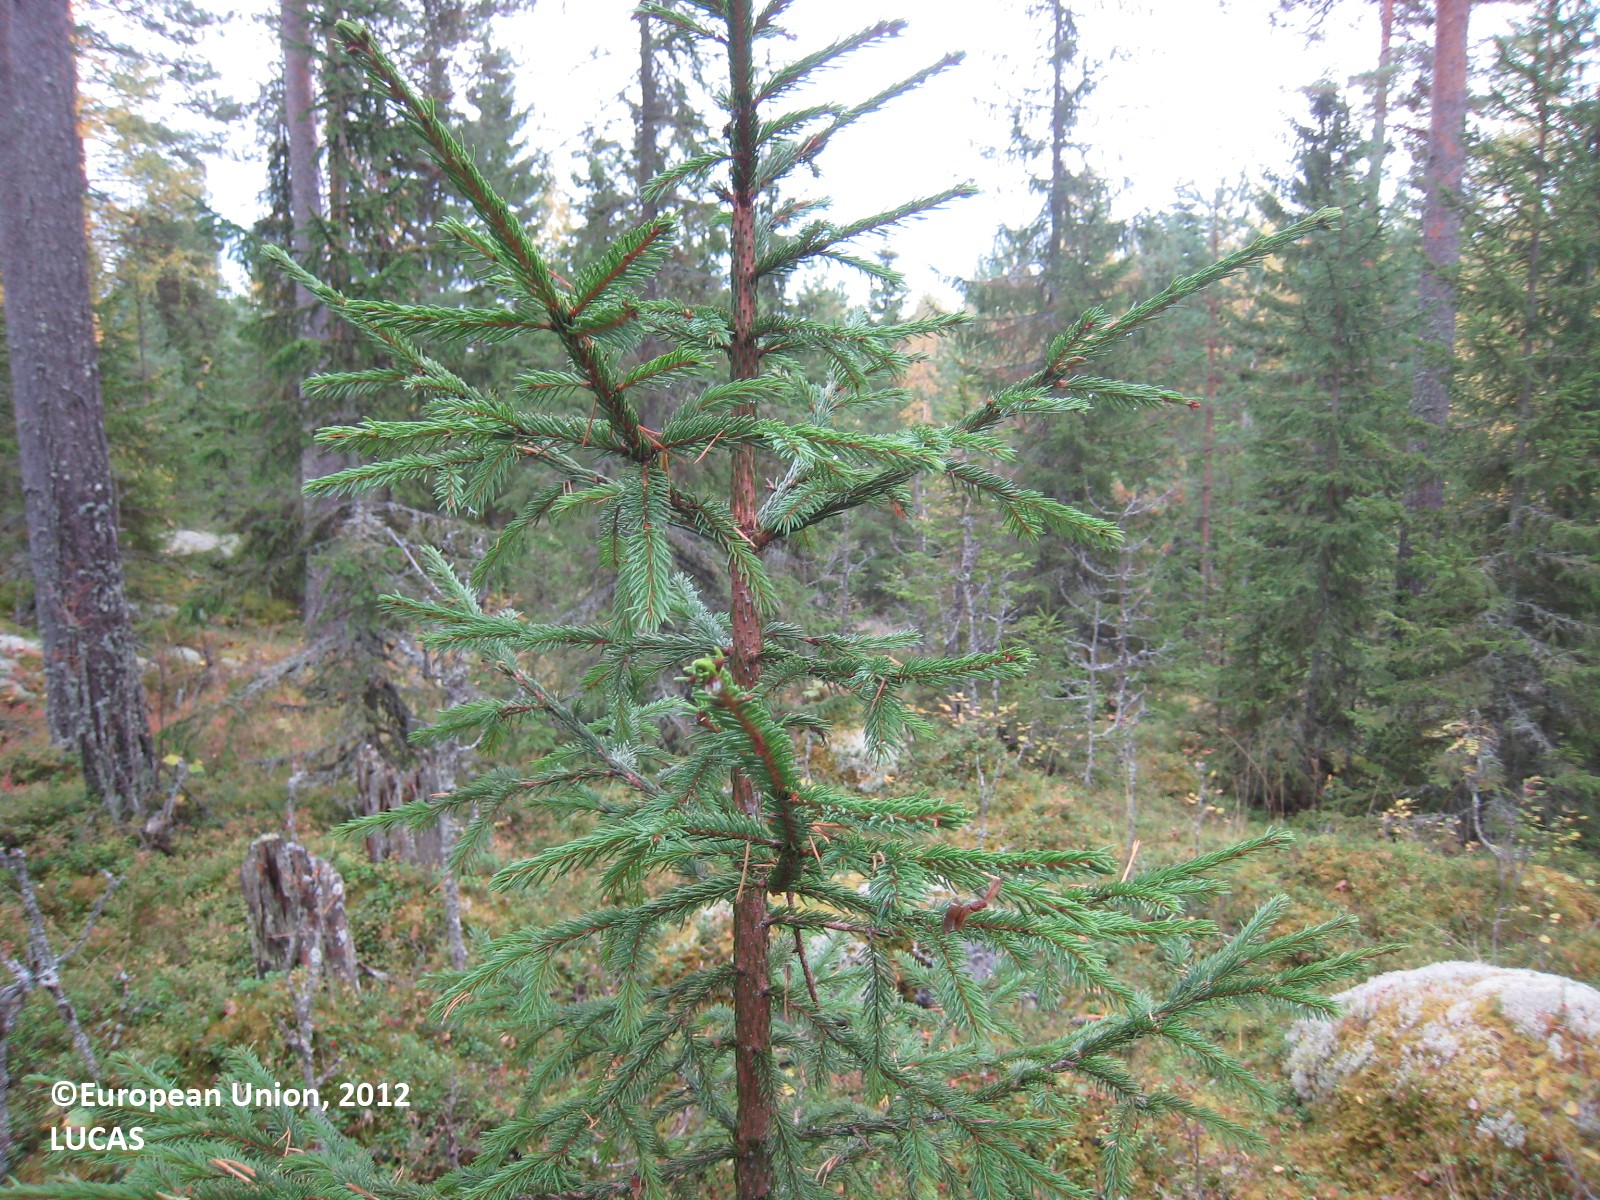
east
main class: Woodland
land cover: Other coniferous woodland
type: boreal forest
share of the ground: 50 - 75 %
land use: Forestry
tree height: > 5 m
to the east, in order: Other coniferous woodland; Ditches and canals; Grassland with sparse tree/shrub cover; Tracks; Grassland without tree/shrub cover; Ditches and canals; Other coniferous woodland; Other mixed woodland
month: September
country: FI
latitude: 62.5363
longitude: 26.5625
